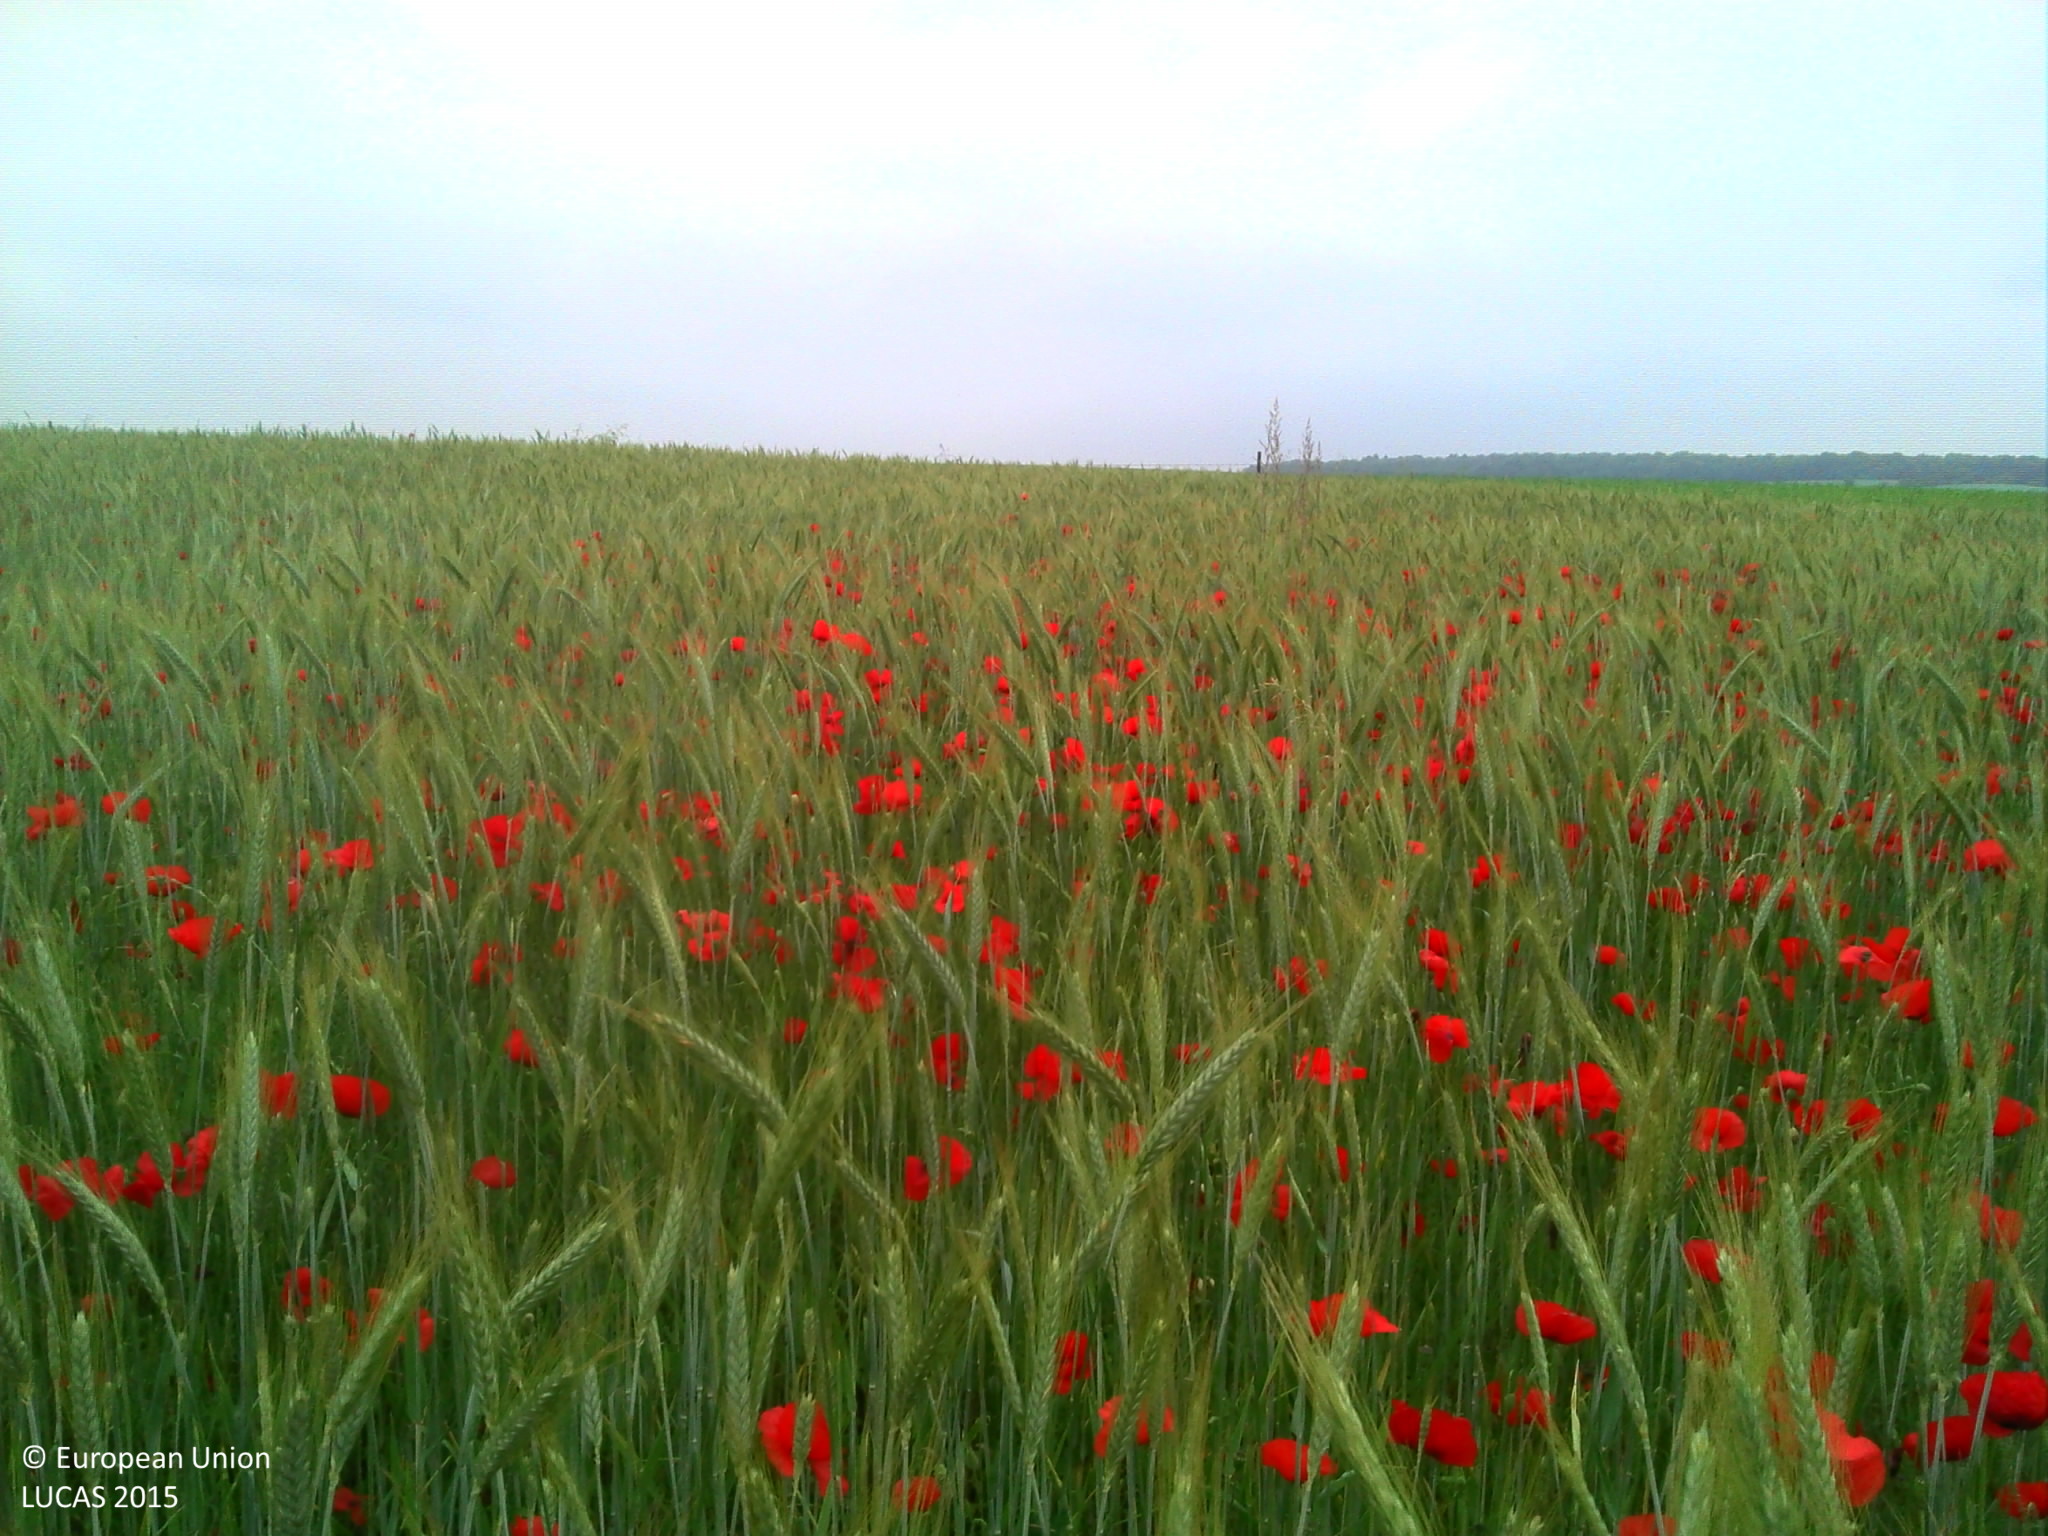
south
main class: Cropland
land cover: Barley
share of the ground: > 75 %
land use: Agriculture (excluding fallow land and kitchen gardens)
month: June
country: FR
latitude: 49.7363
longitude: 2.2021
